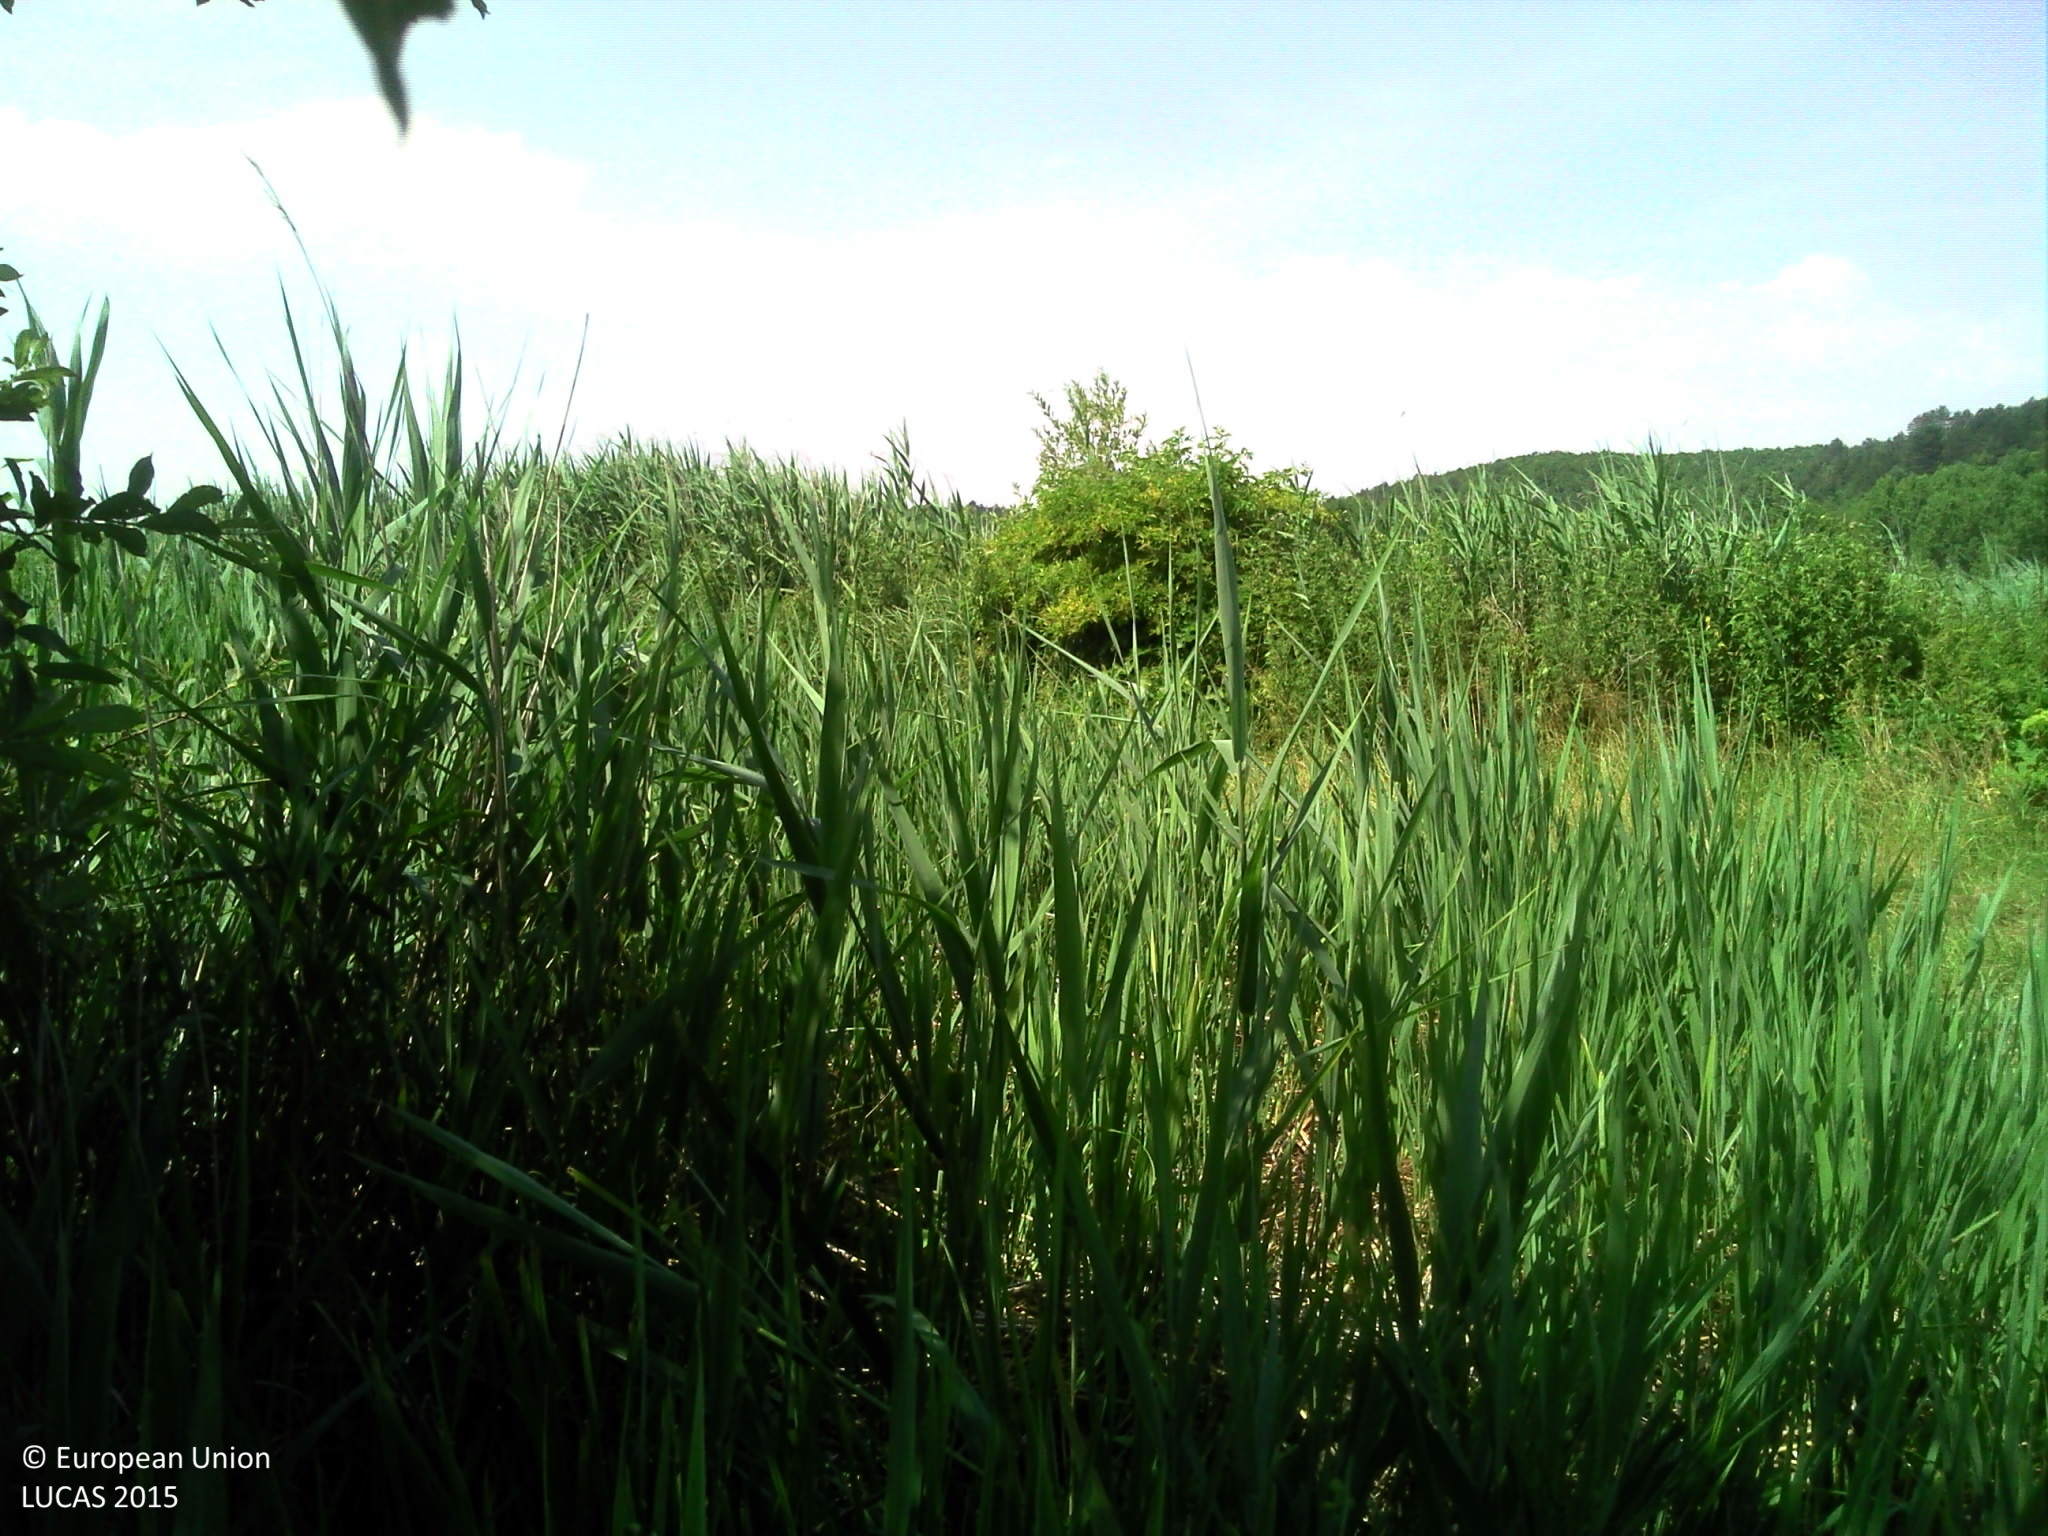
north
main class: Grassland
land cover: Grassland without tree/shrub cover
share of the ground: > 75 %
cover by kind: herbaceous plants 100 %
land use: Agriculture (excluding fallow land and kitchen gardens)
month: July
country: FR
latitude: 47.5247
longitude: 3.4749
